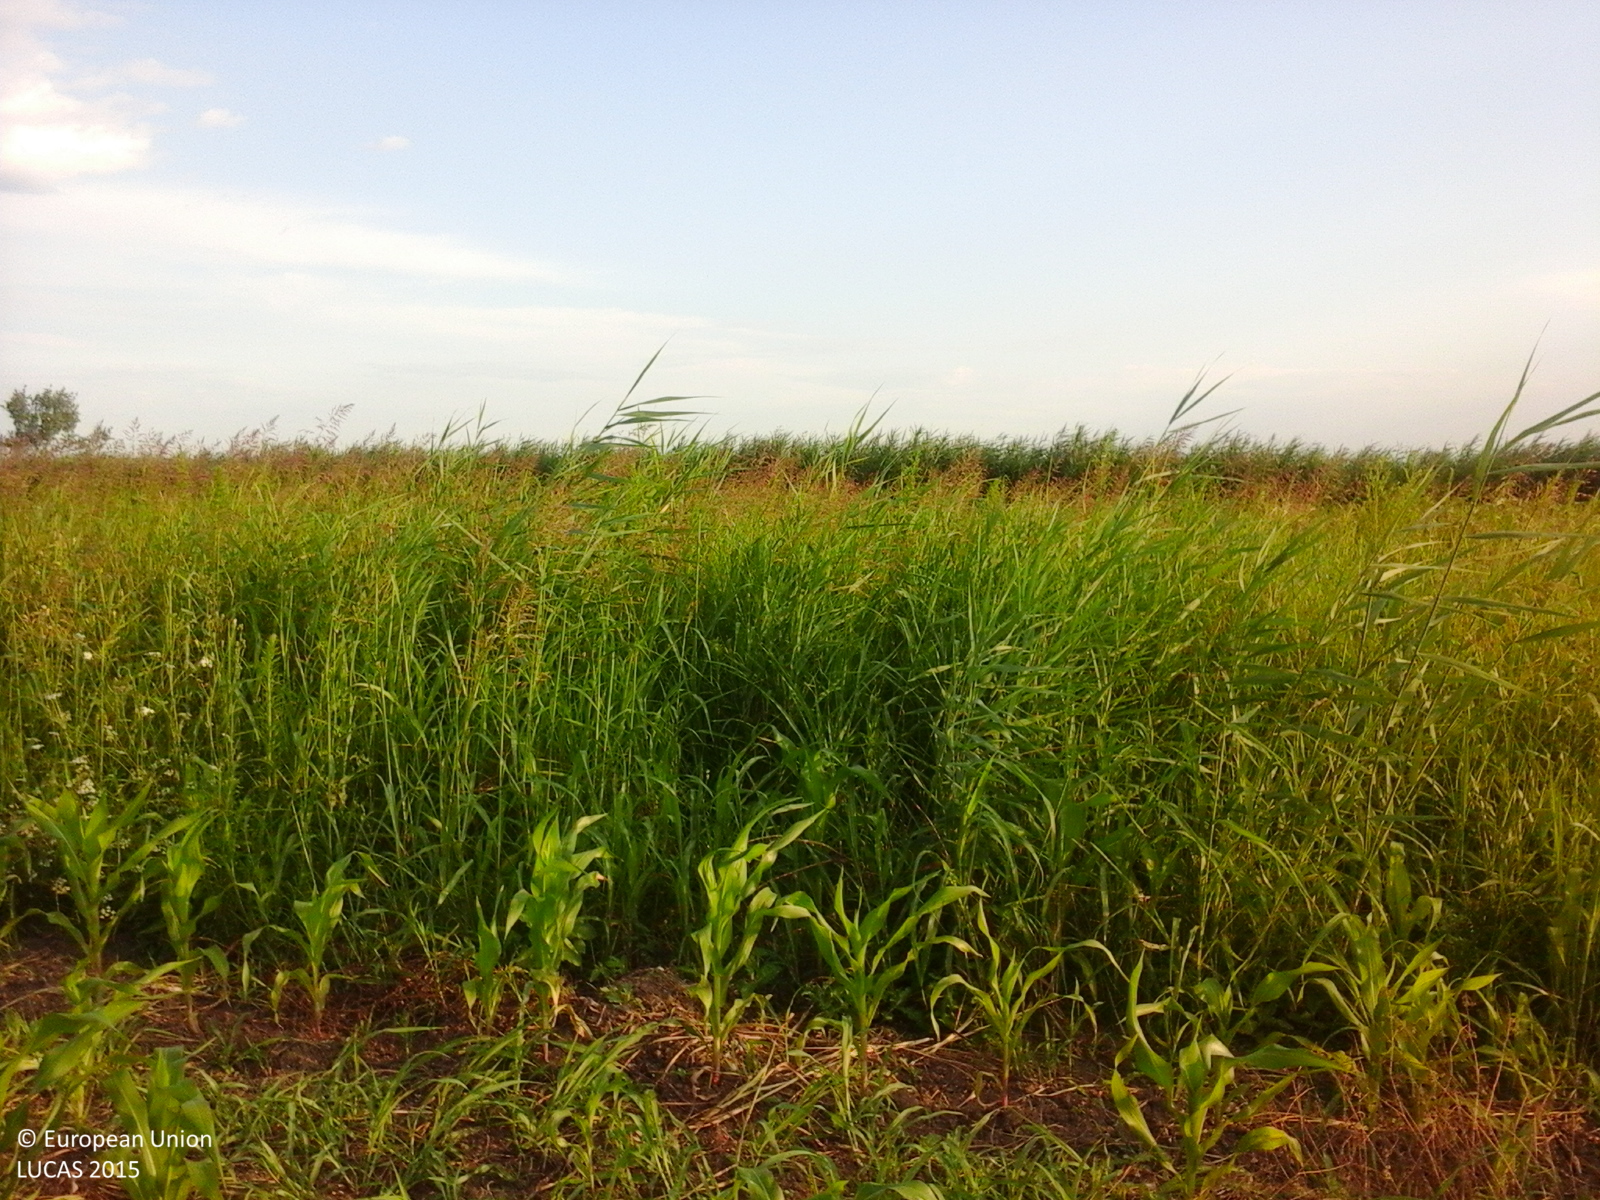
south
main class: Cropland
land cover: Maize
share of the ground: 50 - 75 %
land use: Agriculture (excluding fallow land and kitchen gardens)
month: July
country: RO
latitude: 43.7586
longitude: 24.1553
